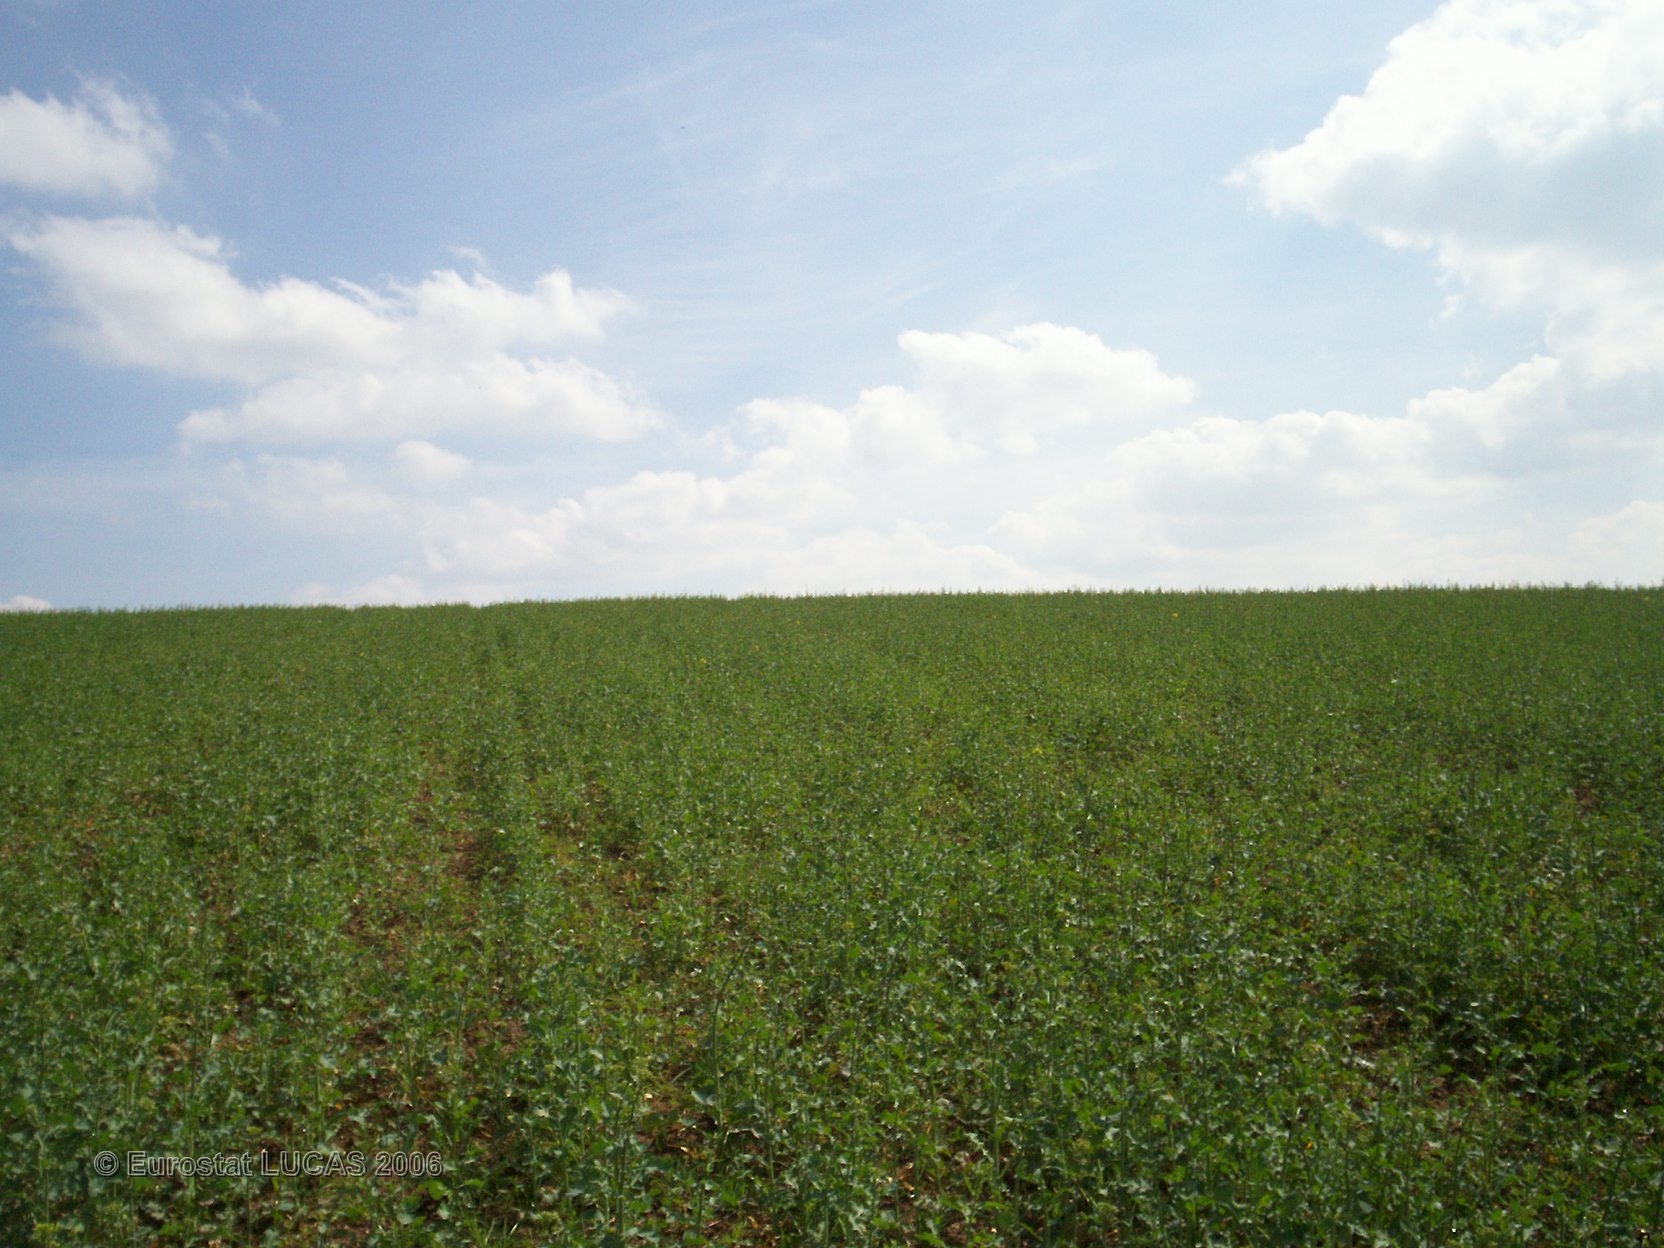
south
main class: Cropland
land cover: Rape and turnip rape
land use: Agriculture (excluding fallow land and kitchen gardens)
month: May
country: FR
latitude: 49.8438
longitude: 4.3080
